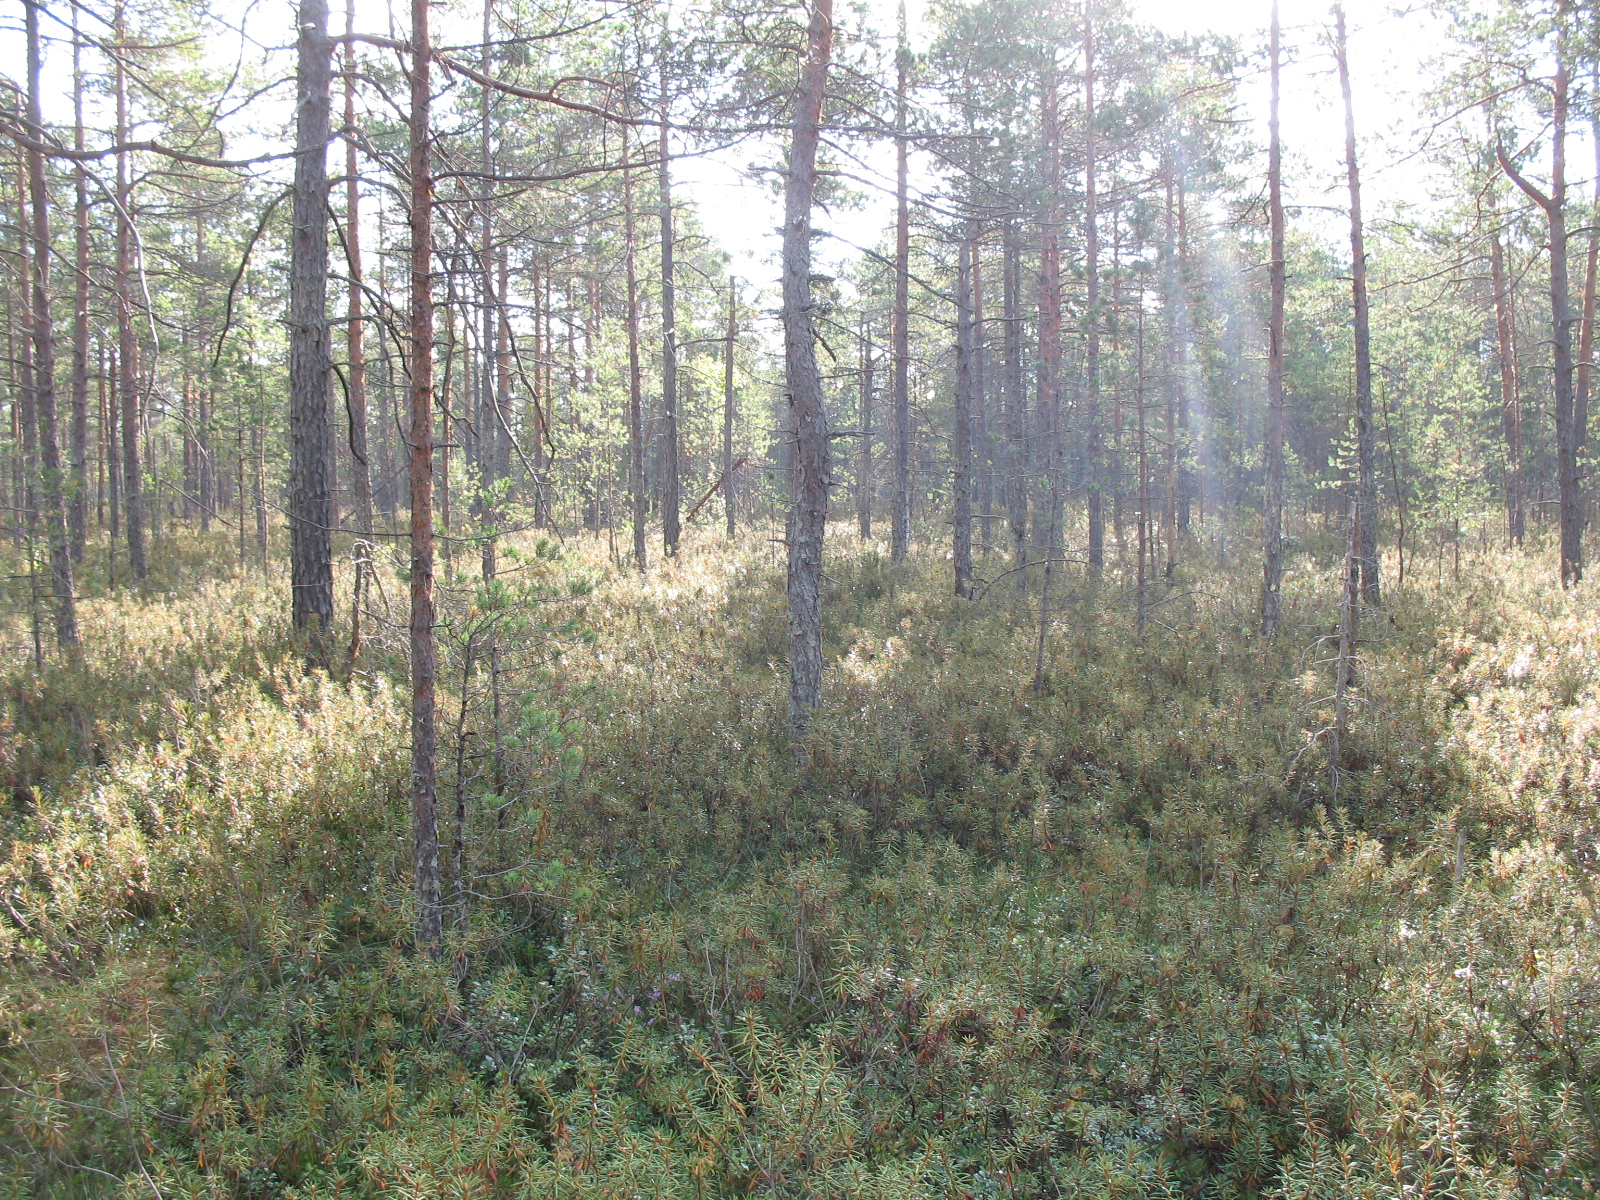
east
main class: Woodland
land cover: Pine dominated coniferous woodland
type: hemiboreal forest and nemoral coniferous forest and mixed broadleaved-coniferous forest
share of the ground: 25 - 50 %
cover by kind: coniferous forest trees 40 %, herbaceous plants 30 %, lichens and mosses 30 %
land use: Forestry
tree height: > 5 m
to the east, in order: Pine dominated coniferous woodland
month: August
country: LV
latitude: 56.2619
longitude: 25.9713
